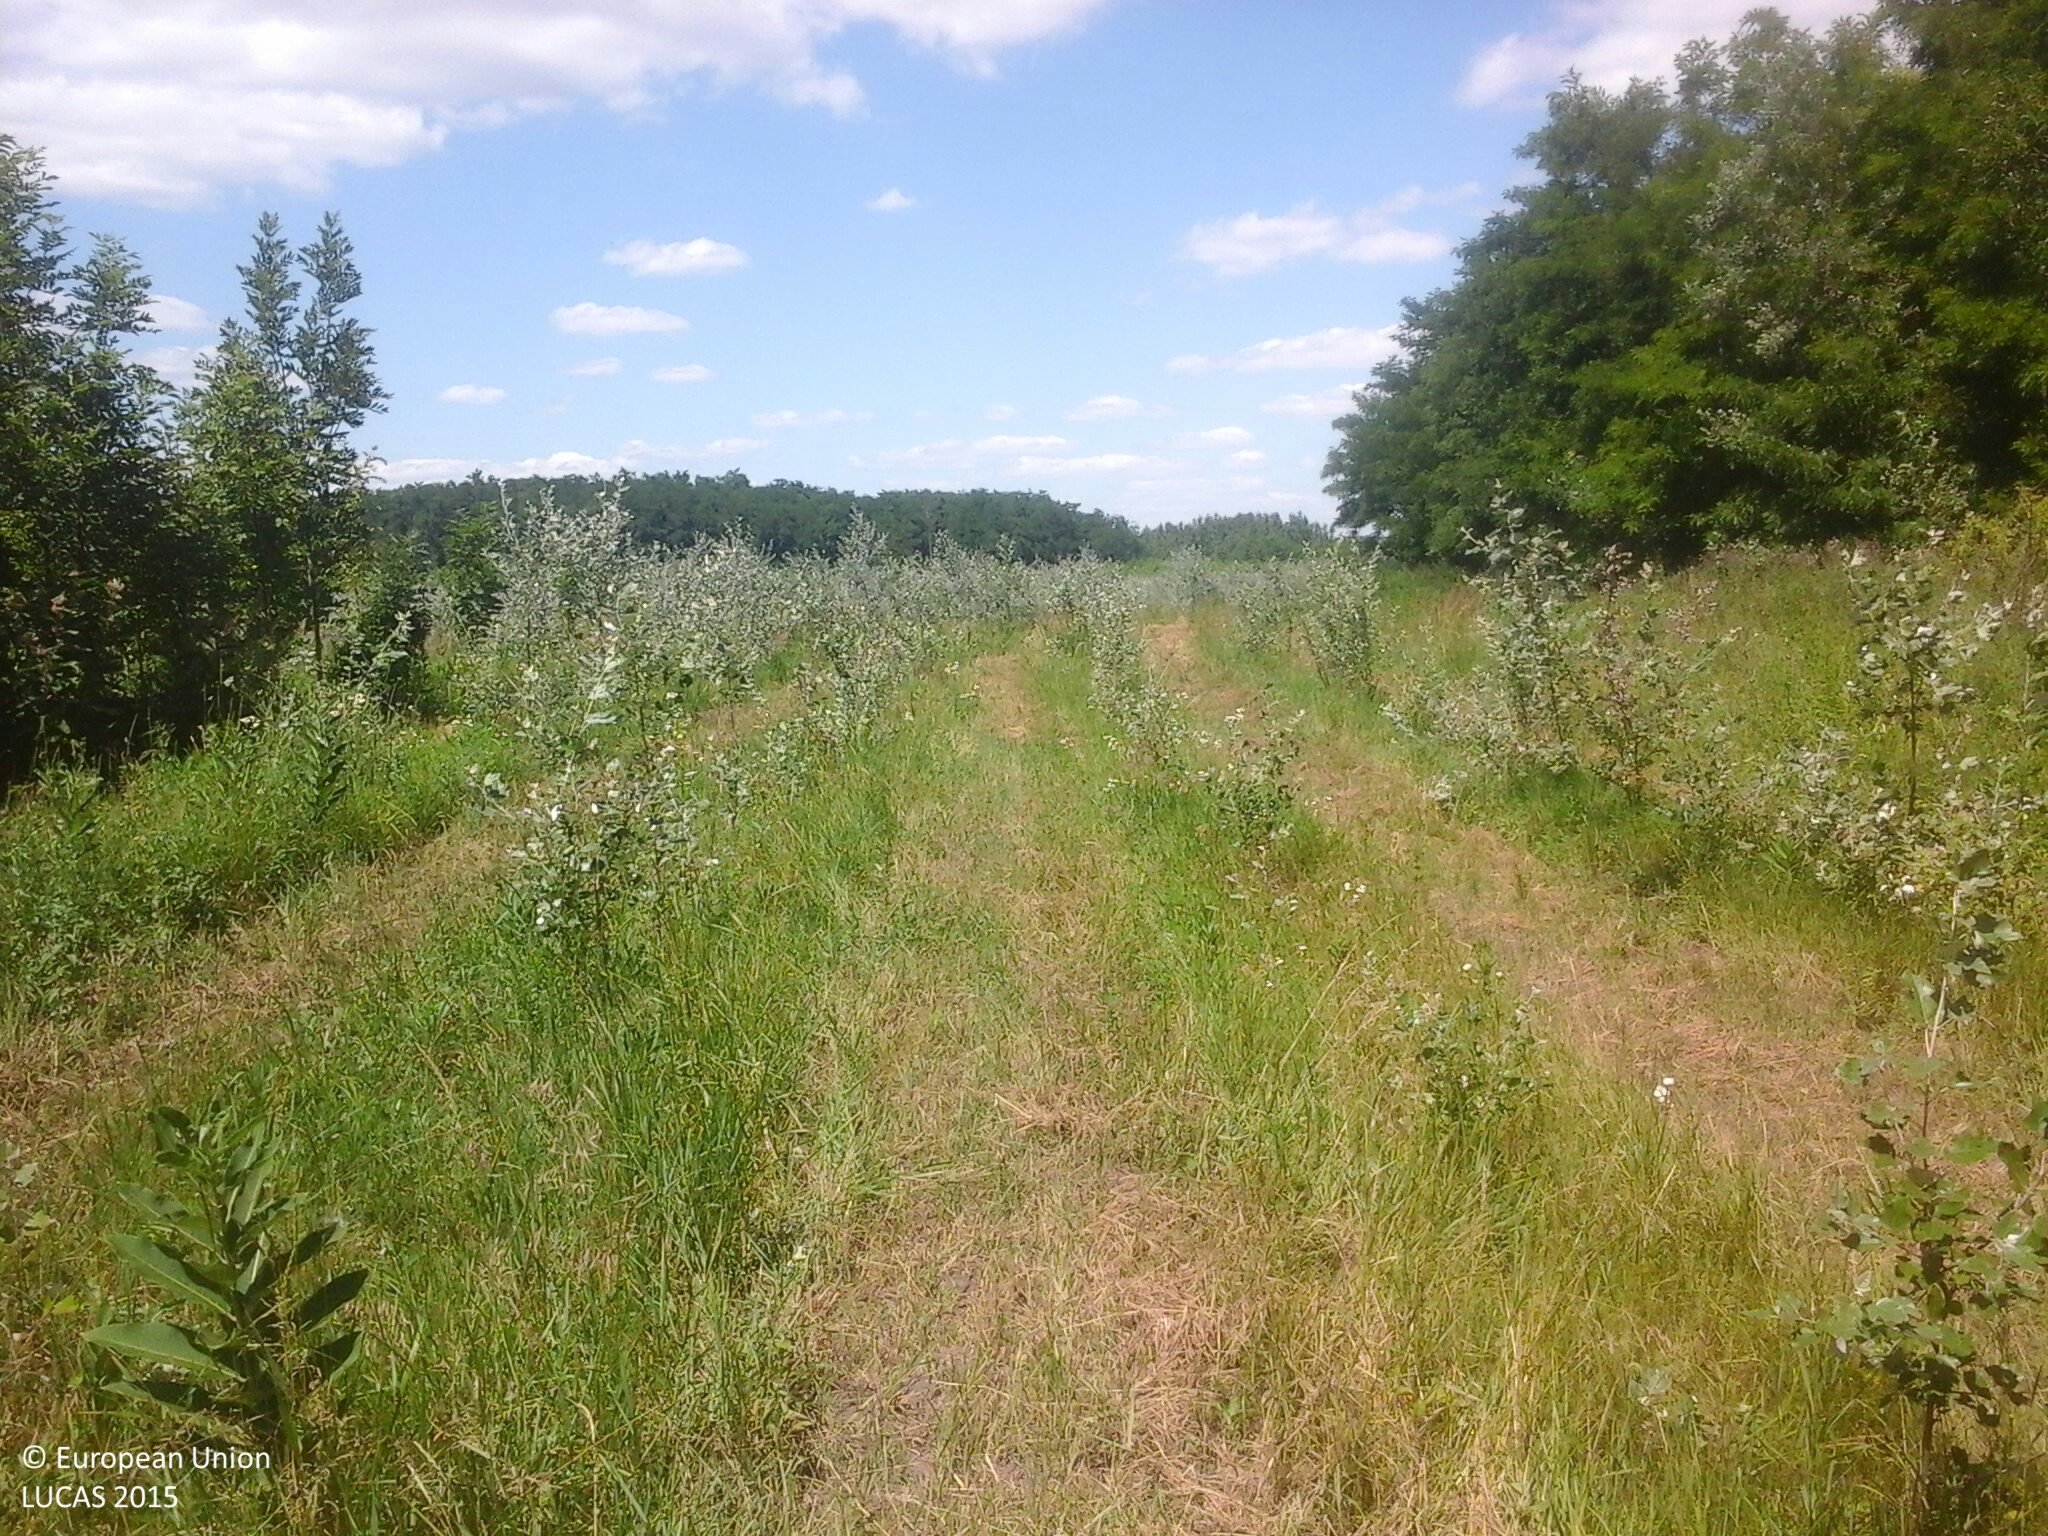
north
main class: Artificial land
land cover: Non built-up linear features
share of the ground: > 75 %
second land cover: Grassland without tree/shrub cover
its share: > 75 %
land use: Agriculture (excluding fallow land and kitchen gardens)
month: July
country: HU
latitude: 47.7865
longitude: 21.8077
